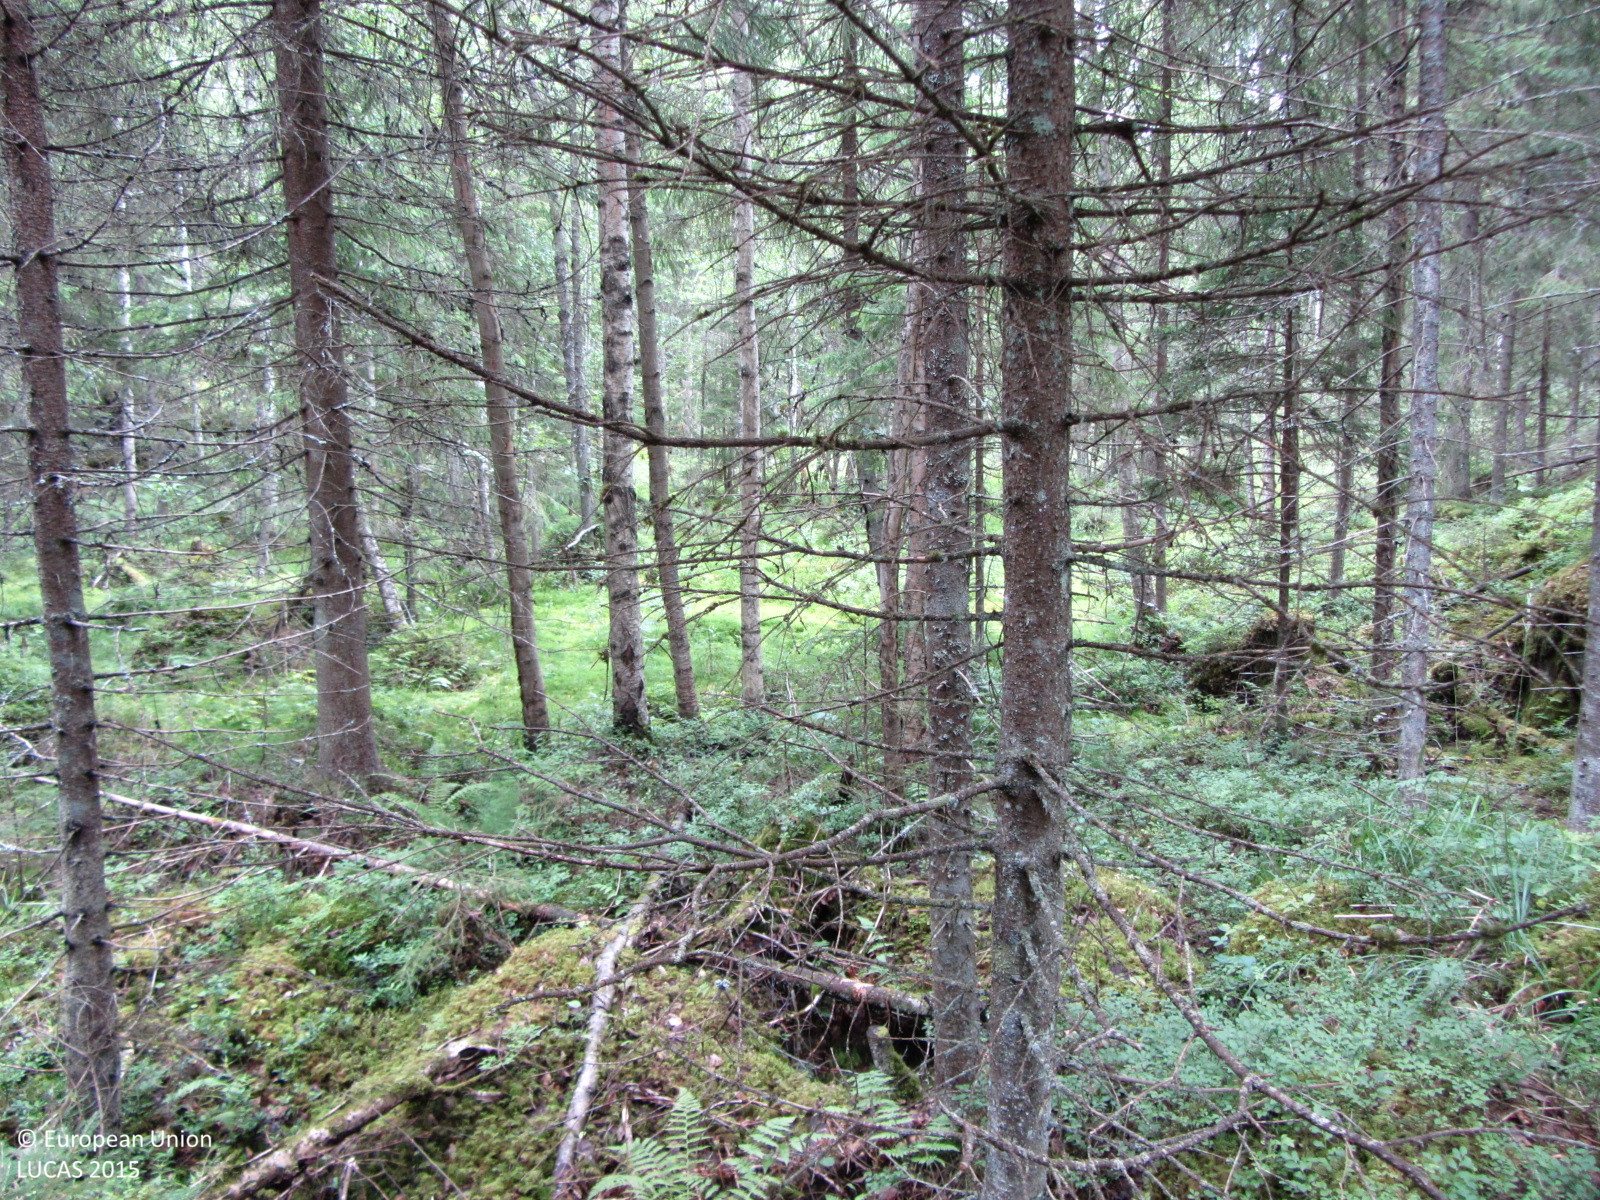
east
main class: Woodland
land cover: Spruce dominated coniferous woodland
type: boreal forest
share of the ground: > 75 %
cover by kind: coniferous forest trees 80 %, shrubs 10 %, broadleaved forest trees 5 %, herbaceous plants 5 %
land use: Forestry
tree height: > 5 m
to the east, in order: Spruce dominated coniferous woodland; Tracks; Spruce dominated coniferous woodland
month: August
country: FI
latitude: 60.6720
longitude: 24.6964
